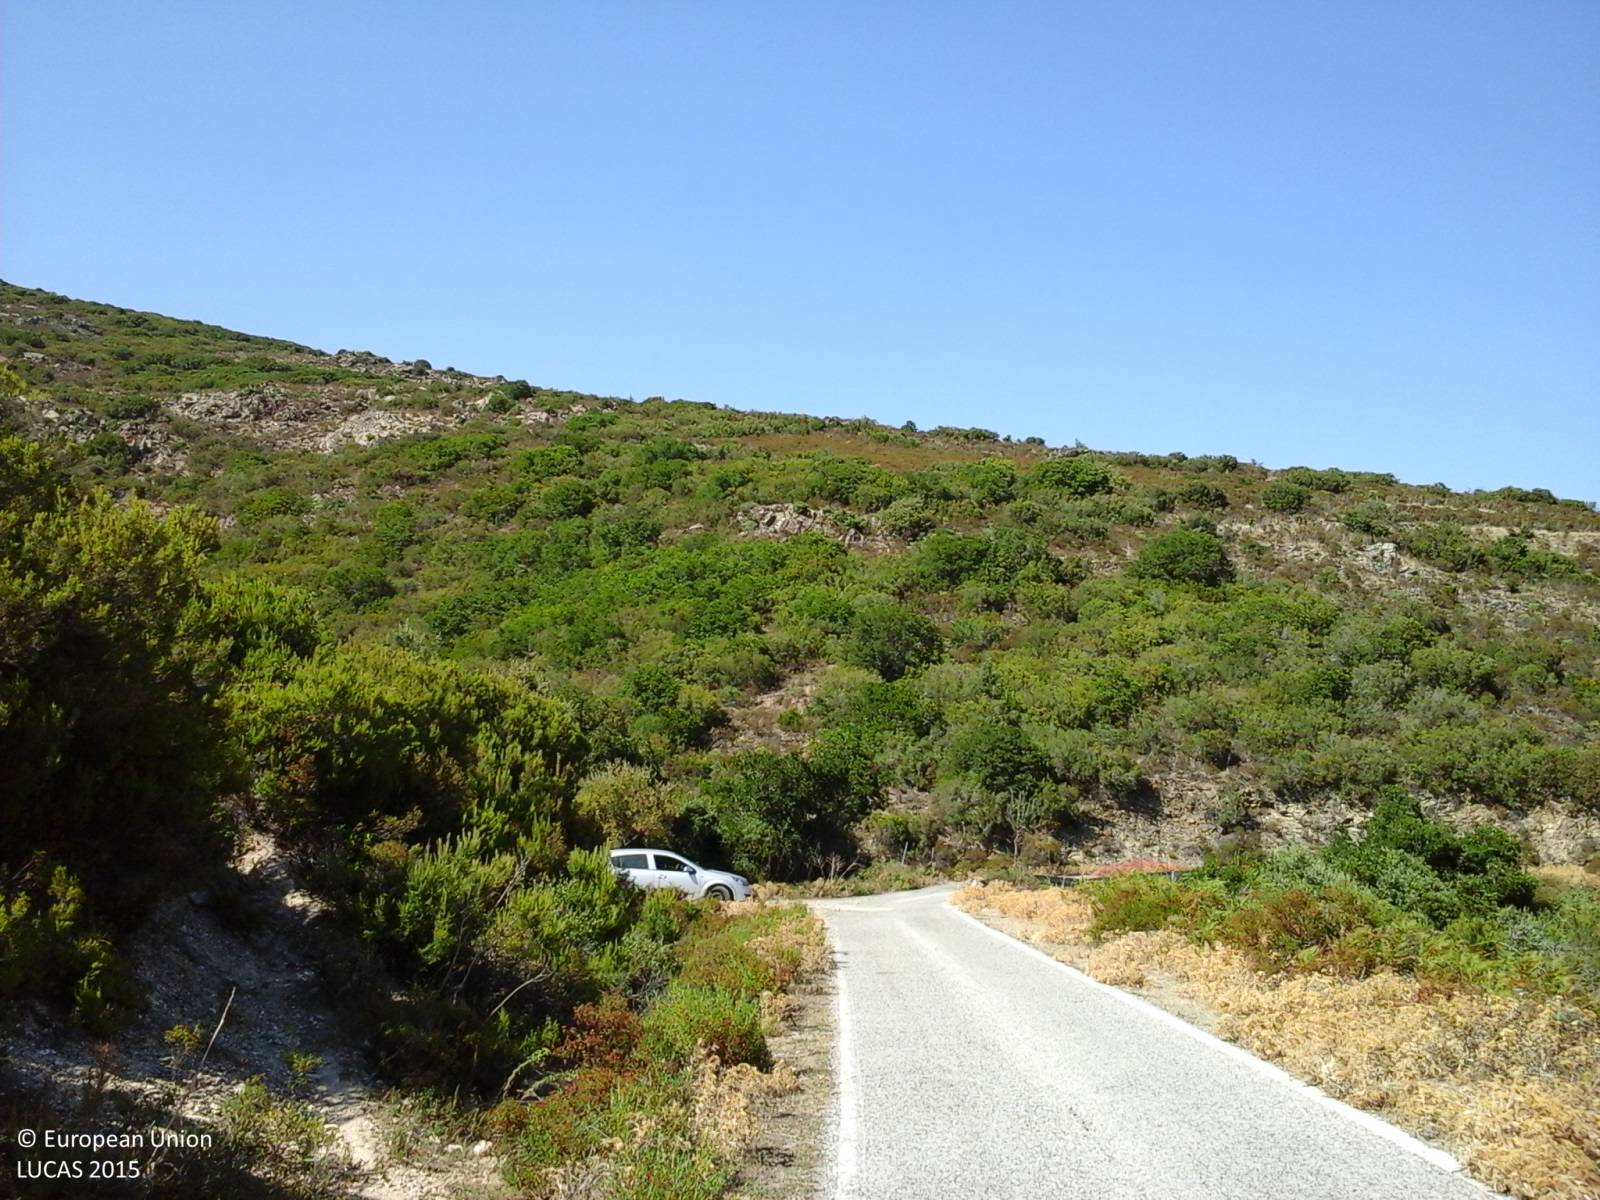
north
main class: Shrubland
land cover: Shrubland with sparse tree cover
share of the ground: > 75 %
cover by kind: shrubs 95 %, broadleaved forest trees 5 %
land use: Agriculture (excluding fallow land and kitchen gardens)
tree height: < 5 m
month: August
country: IT
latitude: 39.7579
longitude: 9.3153
